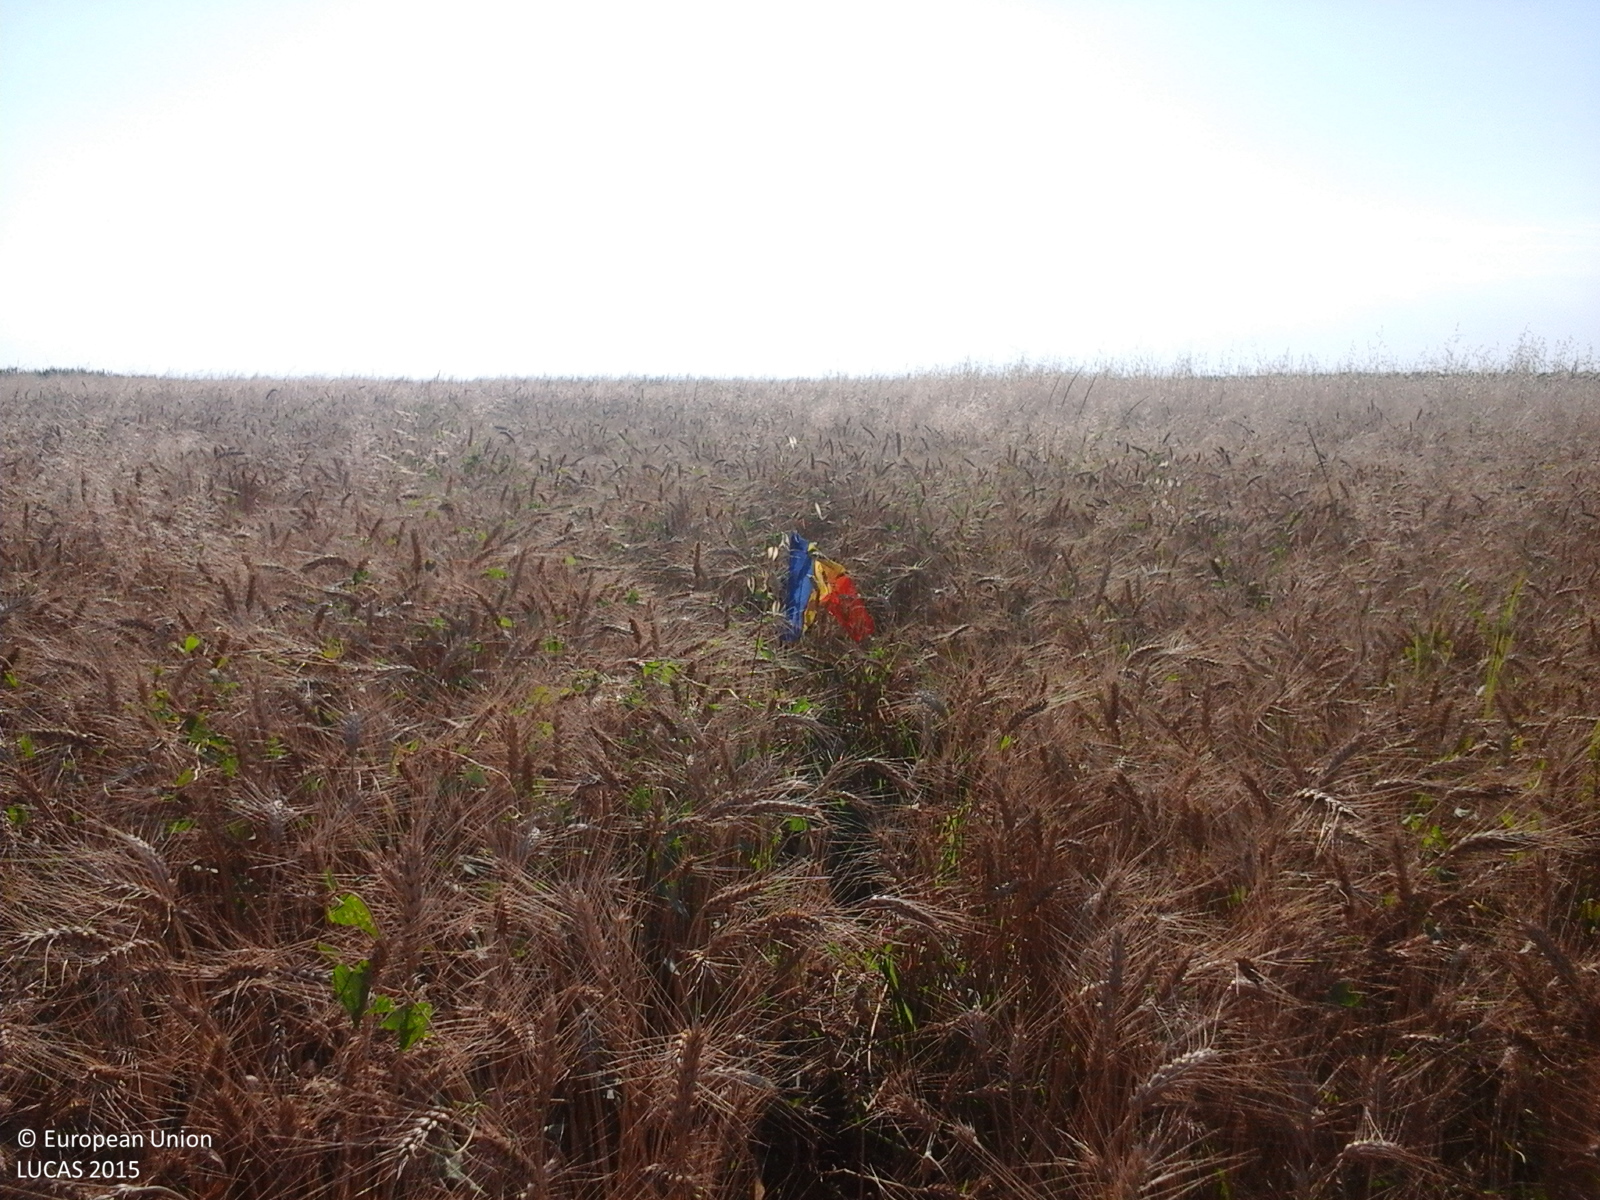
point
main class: Cropland
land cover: Common wheat
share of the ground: > 75 %
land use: Agriculture (excluding fallow land and kitchen gardens)
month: July
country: RO
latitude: 44.5788
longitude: 24.5687
